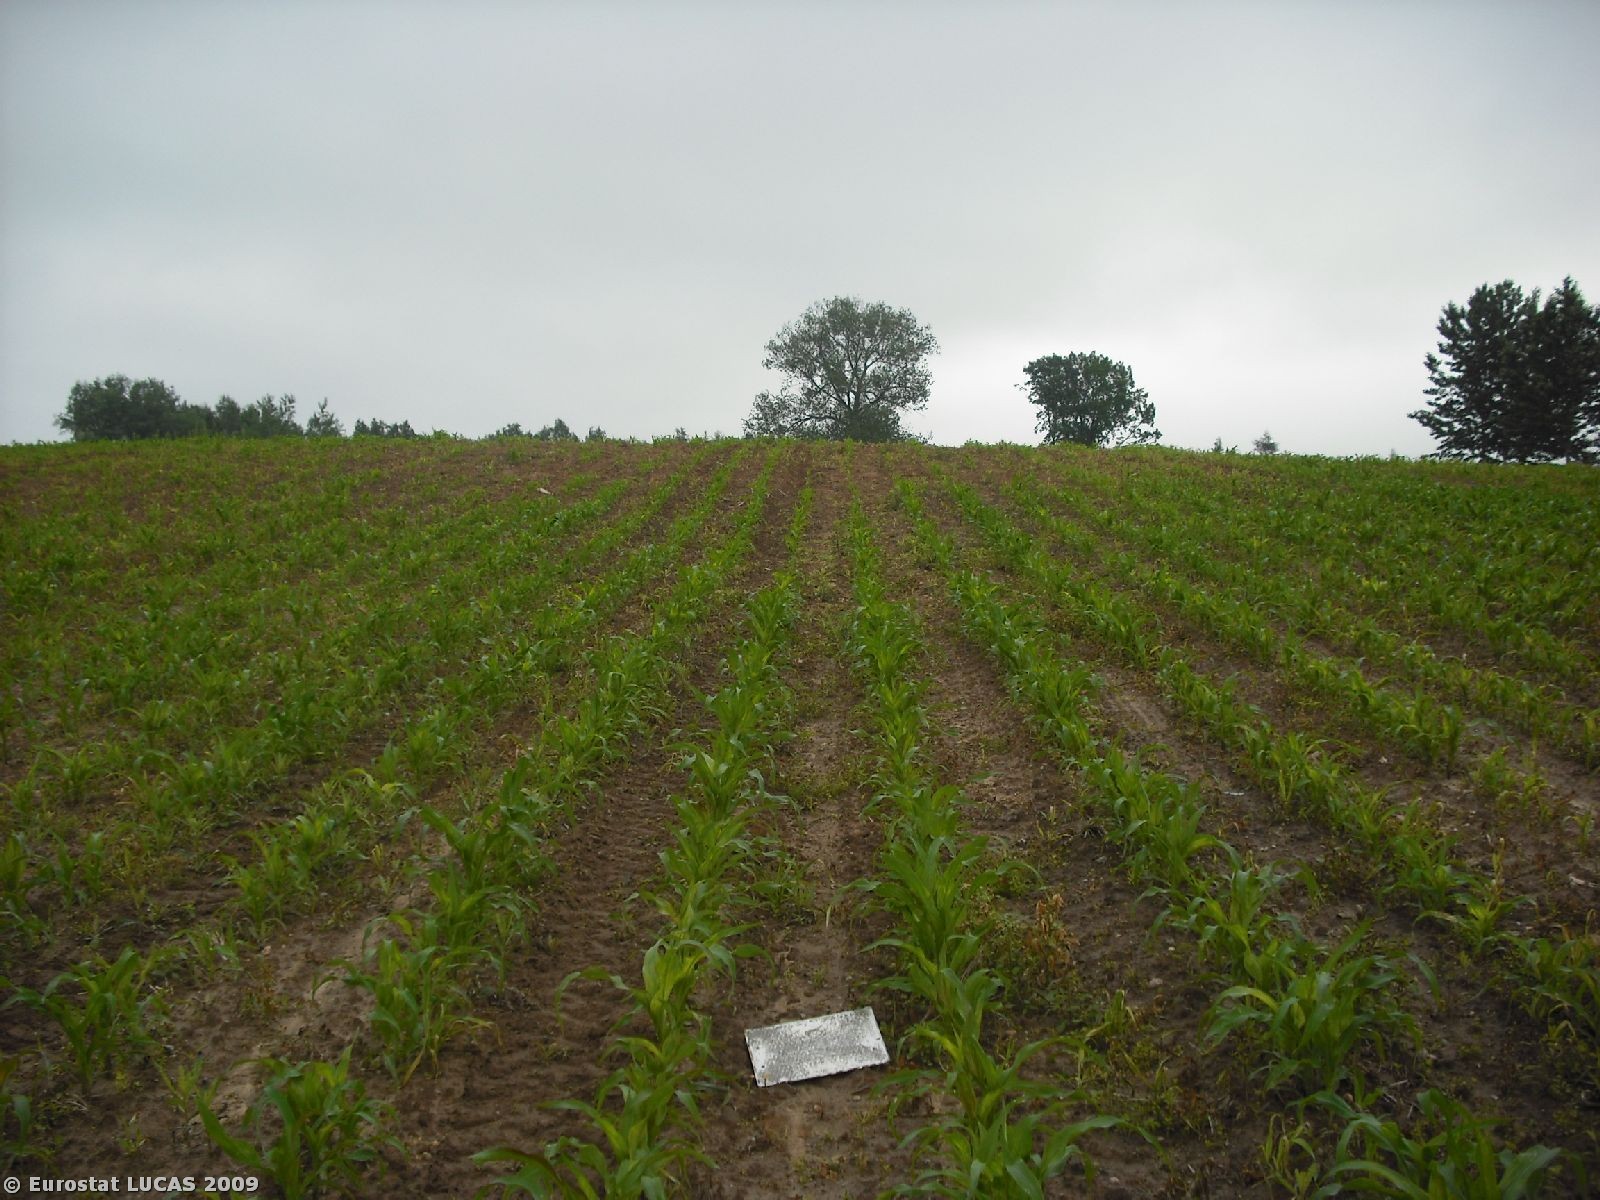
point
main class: Cropland
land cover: Maize
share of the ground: 50 - 75 %
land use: Agriculture (excluding fallow land and kitchen gardens)
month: June
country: PL
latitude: 54.0144
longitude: 22.7819
